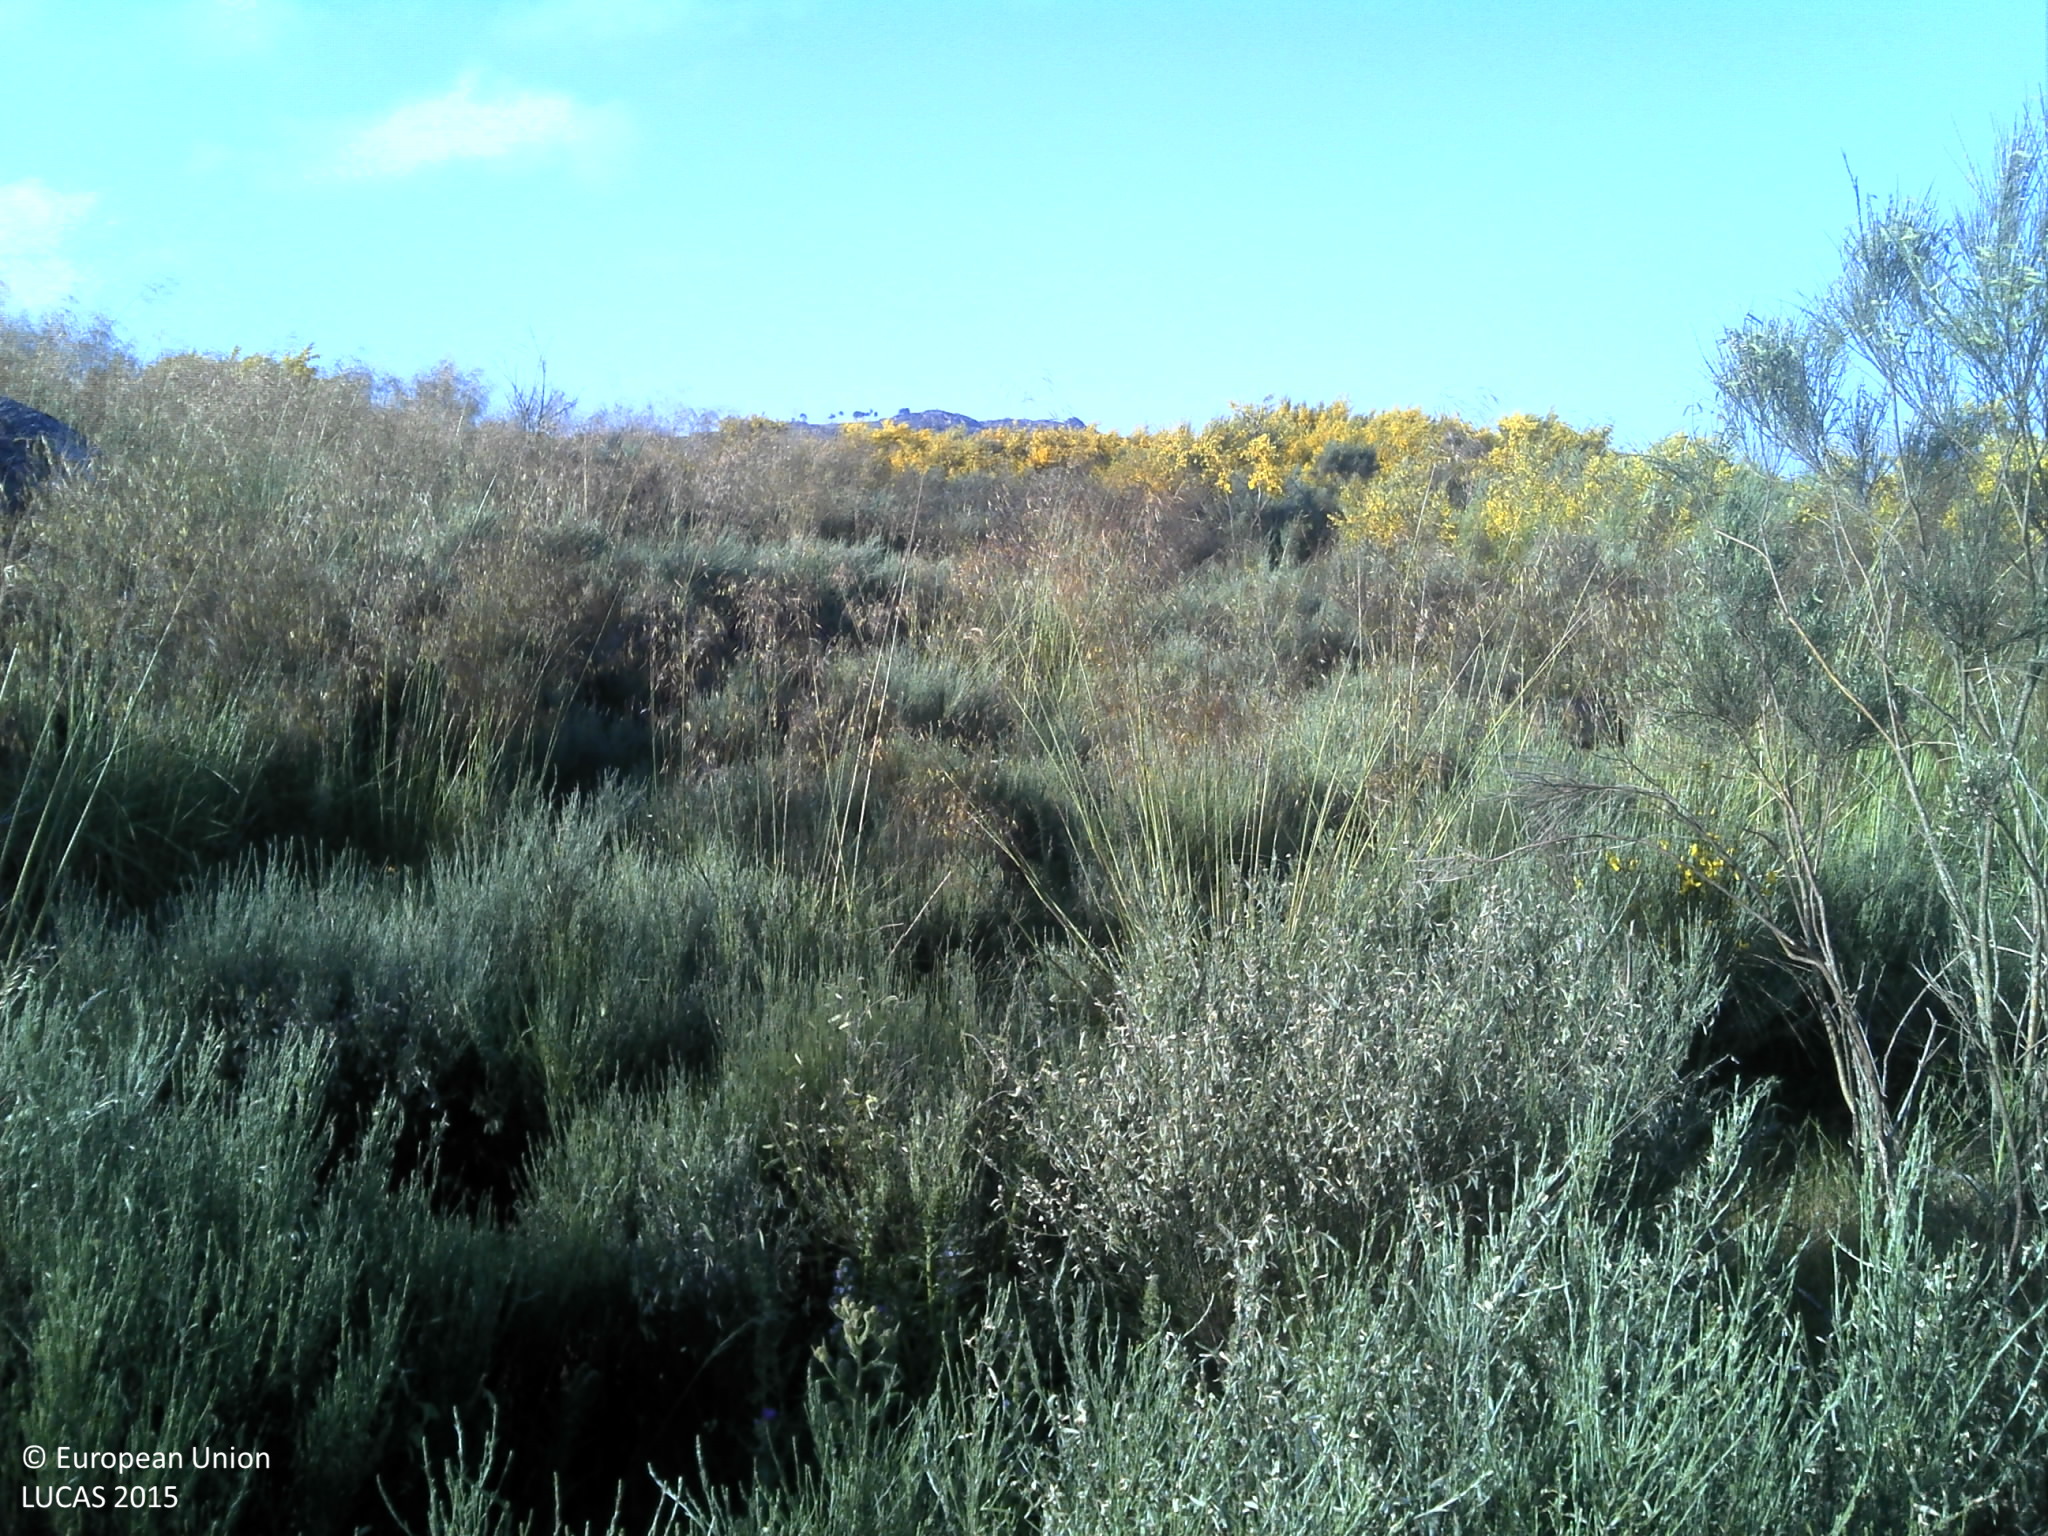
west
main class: Shrubland
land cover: Shrubland without tree cover
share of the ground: 50 - 75 %
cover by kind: shrubs 80 %, herbaceous plants 15 %
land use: Semi-natural and natural areas not in use
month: May
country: PT
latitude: 40.5852
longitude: -7.2736
